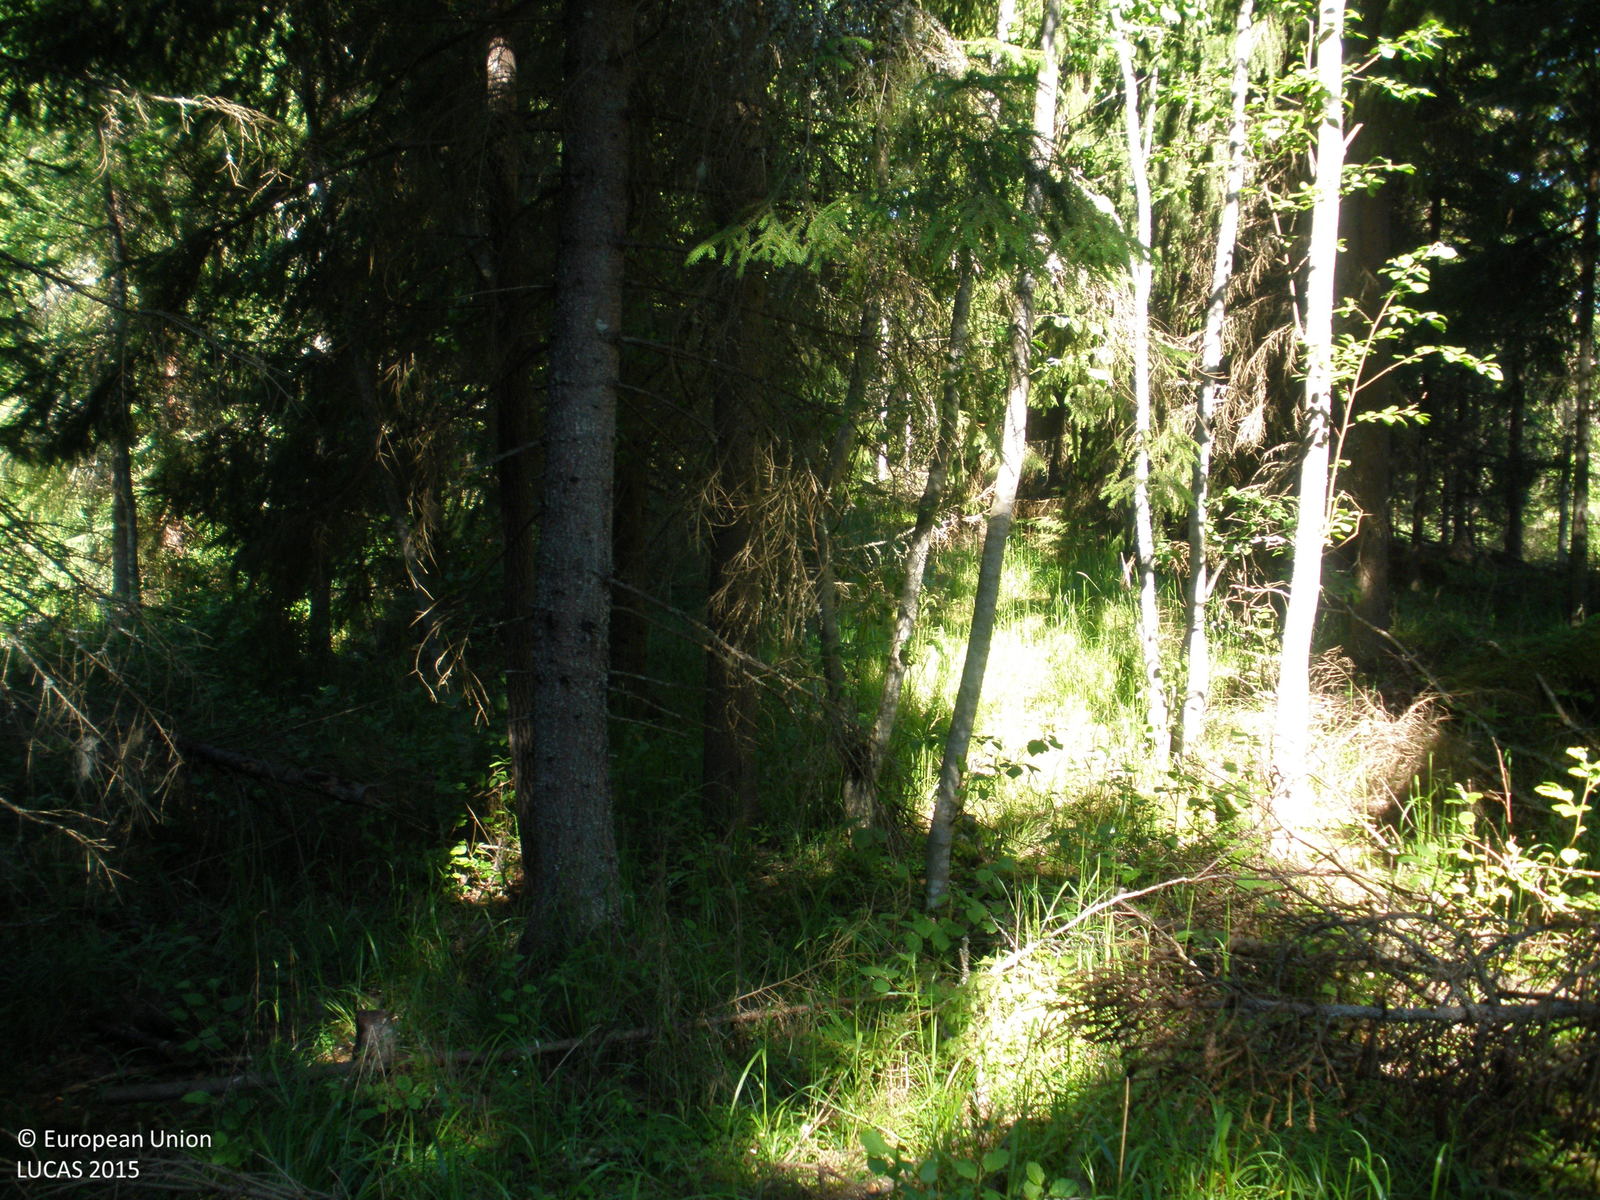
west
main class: Woodland
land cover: Spruce dominated mixed woodland
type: boreal forest
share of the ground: > 75 %
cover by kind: coniferous forest trees 60 %, broadleaved forest trees 25 %, herbaceous plants 15 %
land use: Forestry
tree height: > 5 m
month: July
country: FI
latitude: 61.1949
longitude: 23.6852
